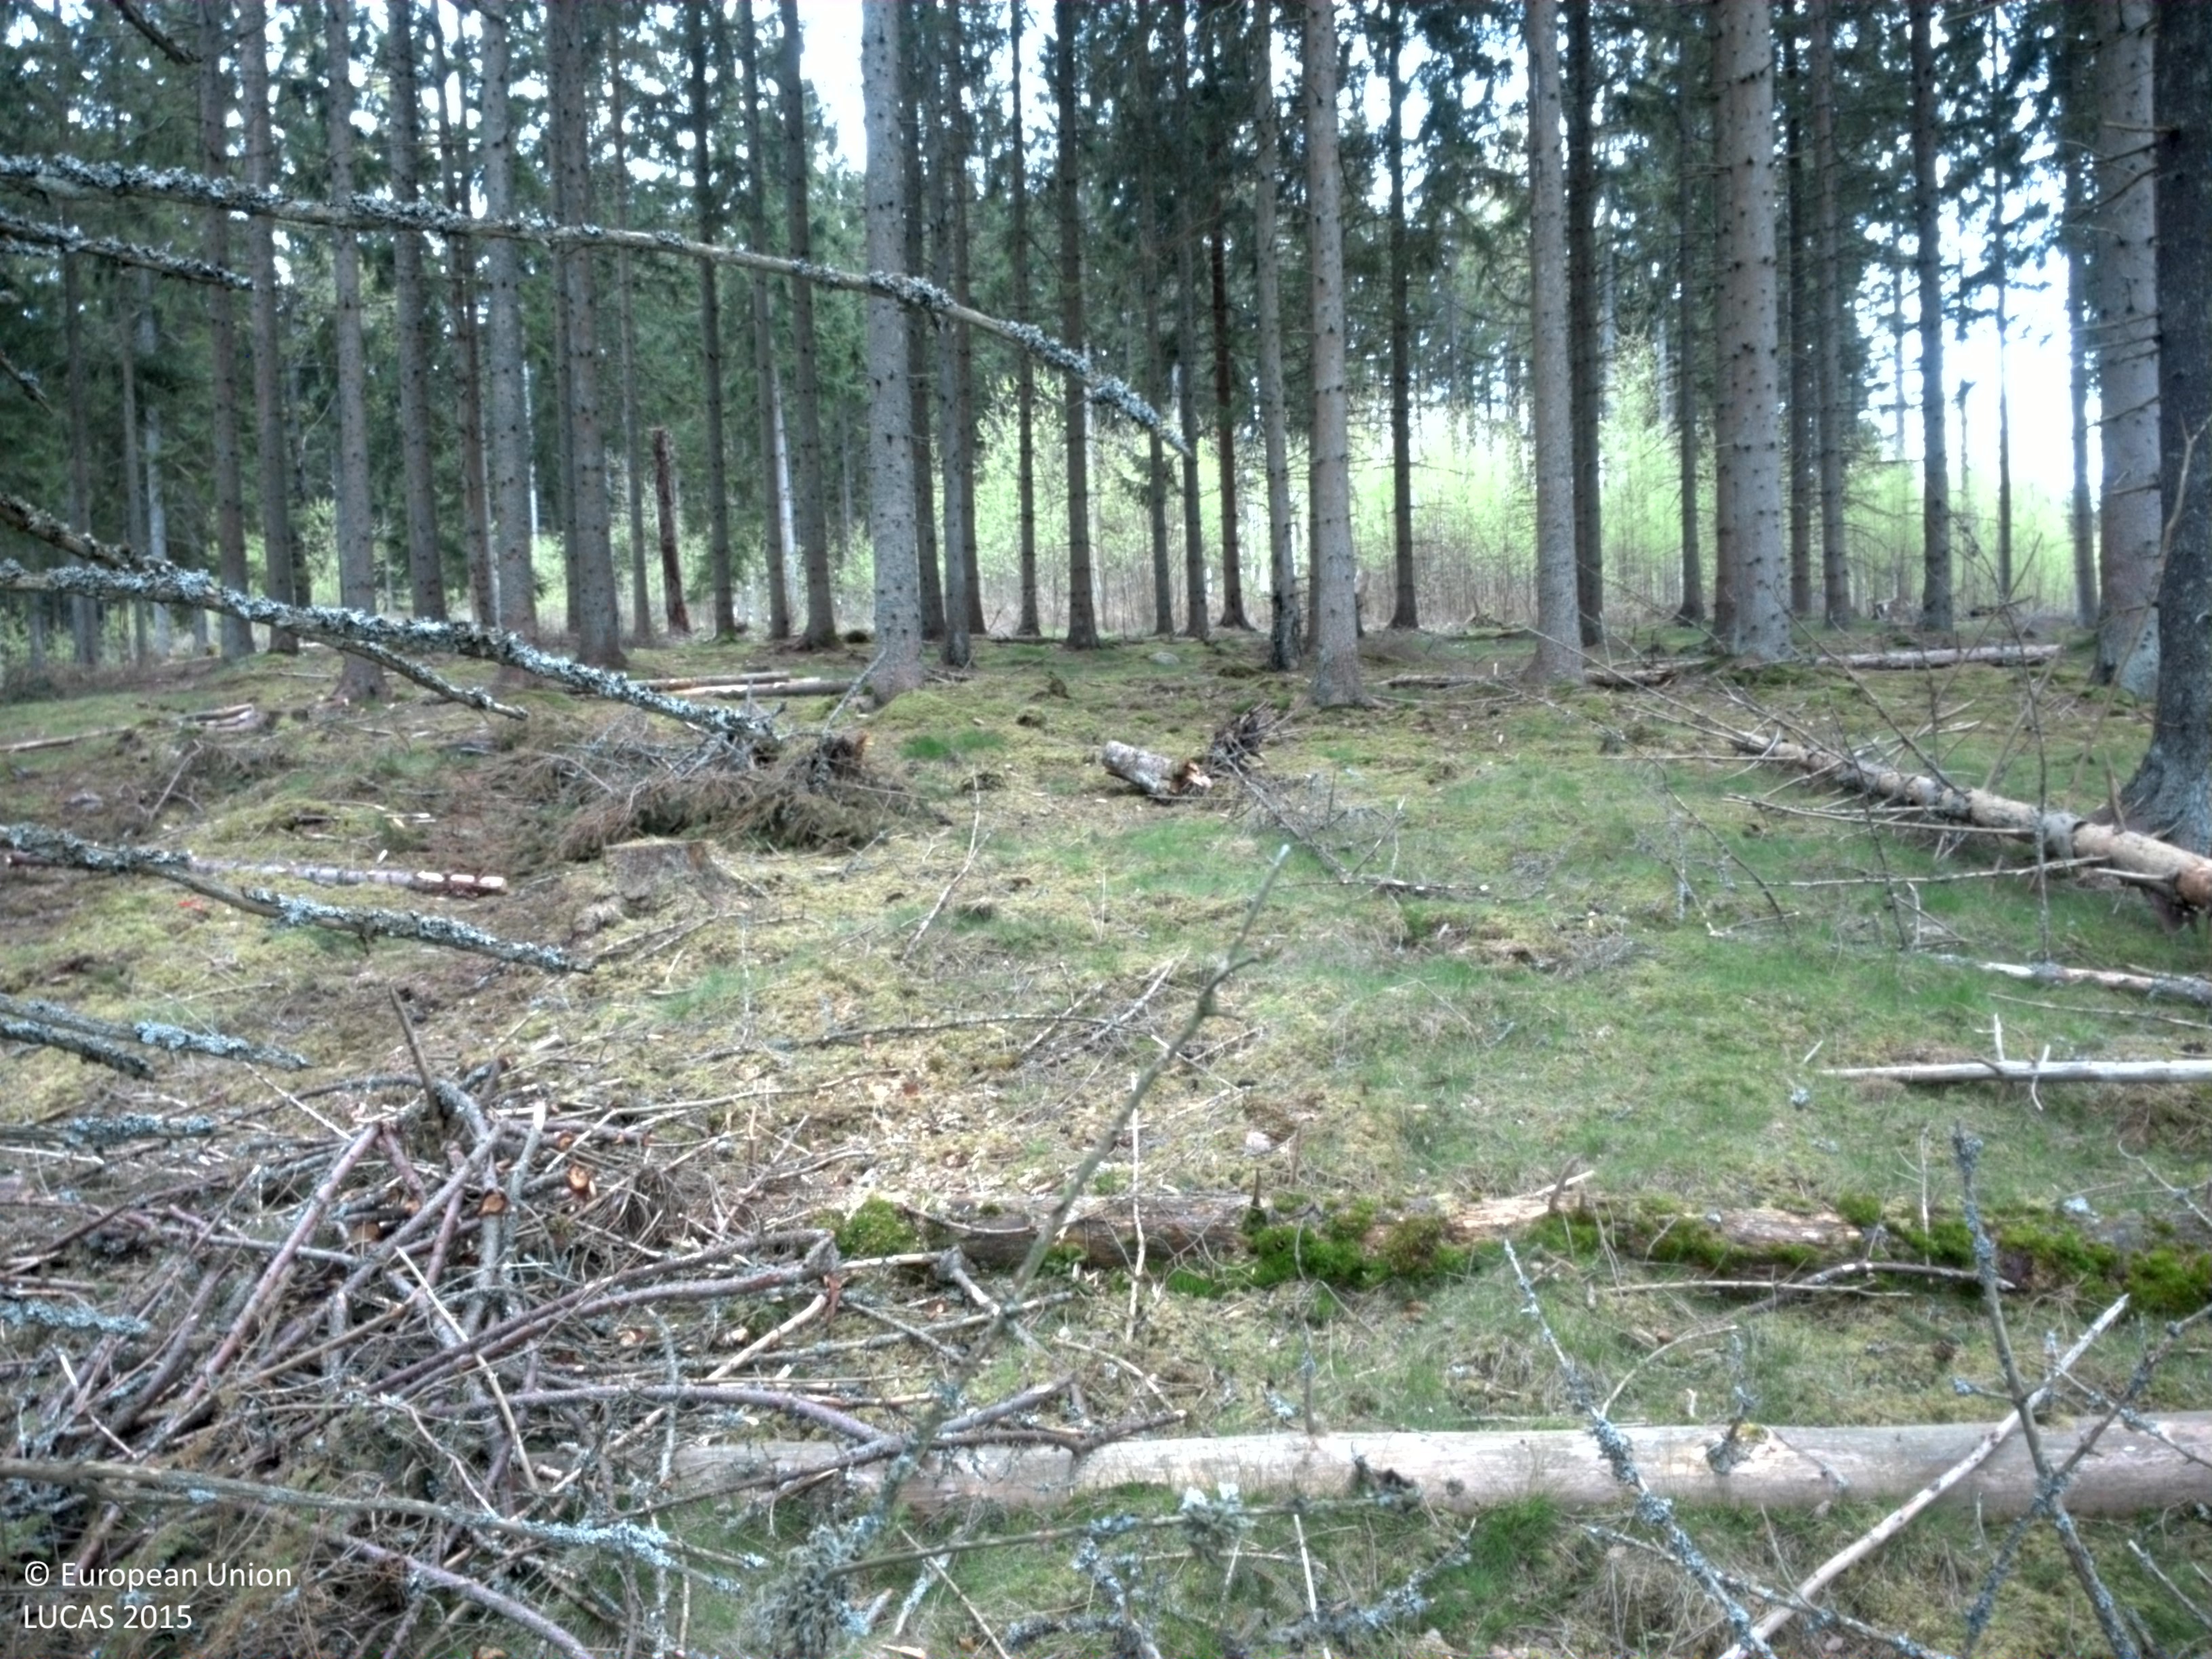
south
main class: Woodland
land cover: Spruce dominated coniferous woodland
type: boreal forest
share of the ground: > 75 %
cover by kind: coniferous forest trees 80 %, lichens and mosses 20 %
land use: Forestry
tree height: > 5 m
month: May
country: SE
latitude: 56.8378
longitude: 14.7671
